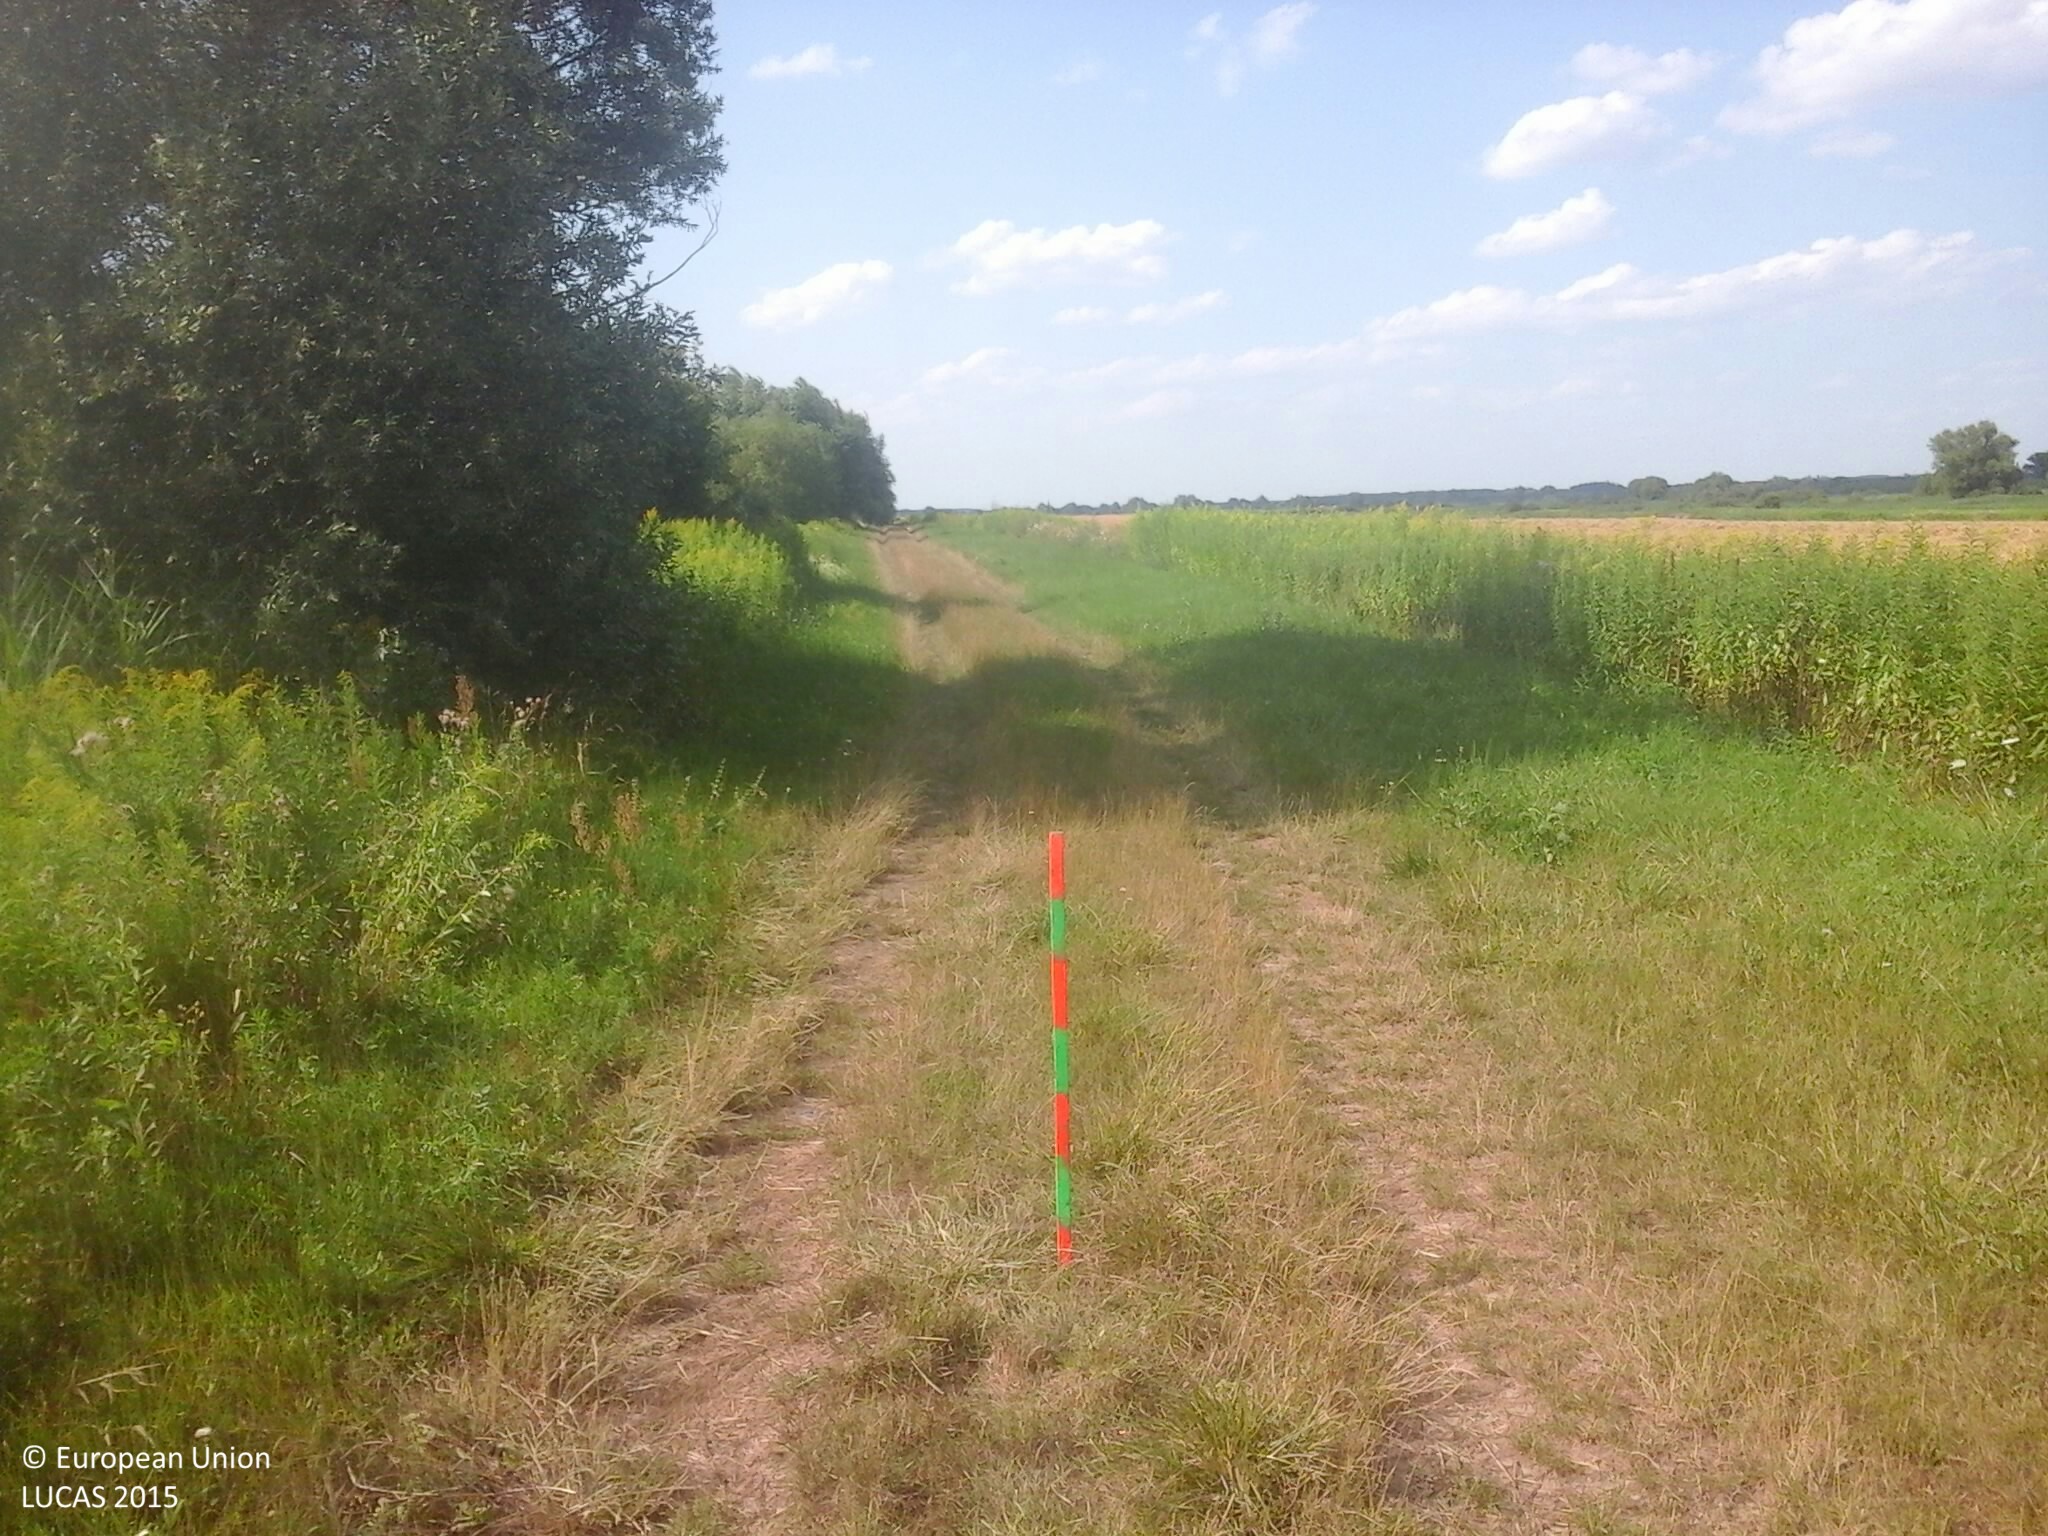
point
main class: Grassland
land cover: Spontaneously vegetated surfaces
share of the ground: > 75 %
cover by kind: herbaceous plants 100 %
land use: Semi-natural and natural areas not in use
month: July
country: HU
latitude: 46.9961
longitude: 17.1719
